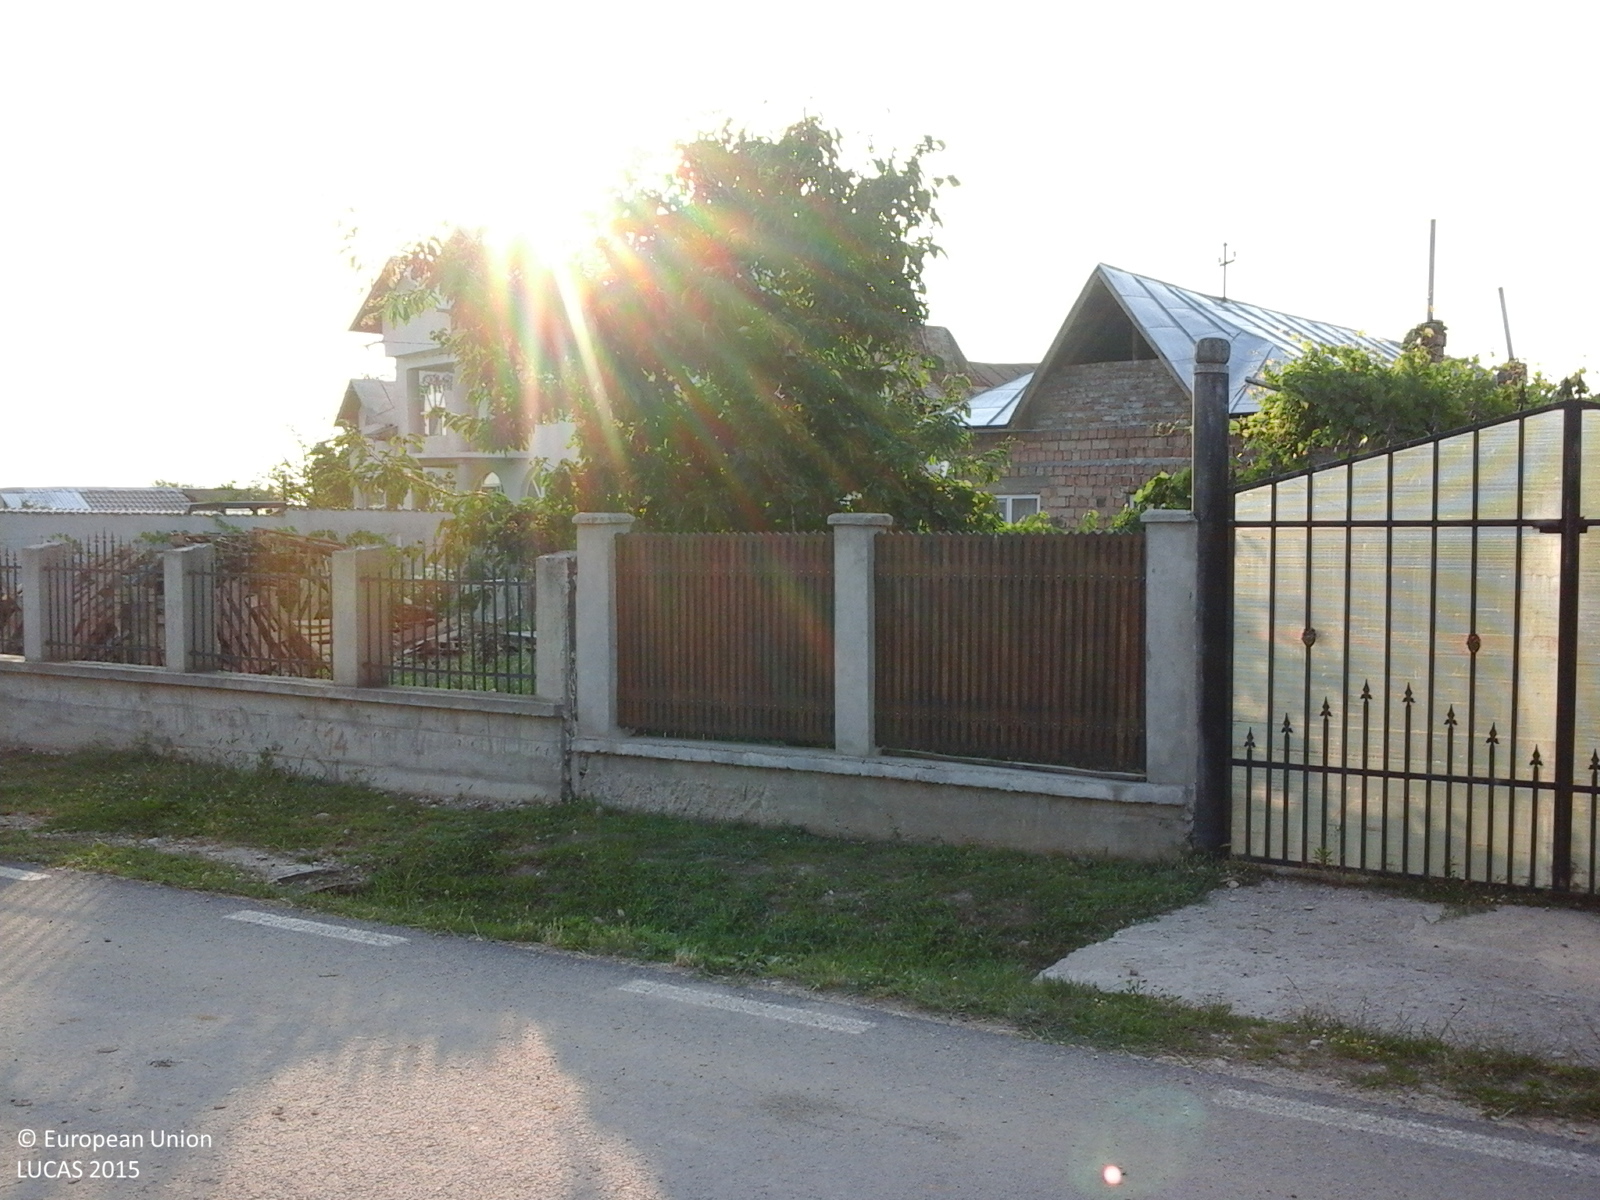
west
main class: Cropland
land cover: Maize
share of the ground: > 75 %
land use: Agriculture (excluding fallow land and kitchen gardens)
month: July
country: RO
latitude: 44.8599
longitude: 25.6517
